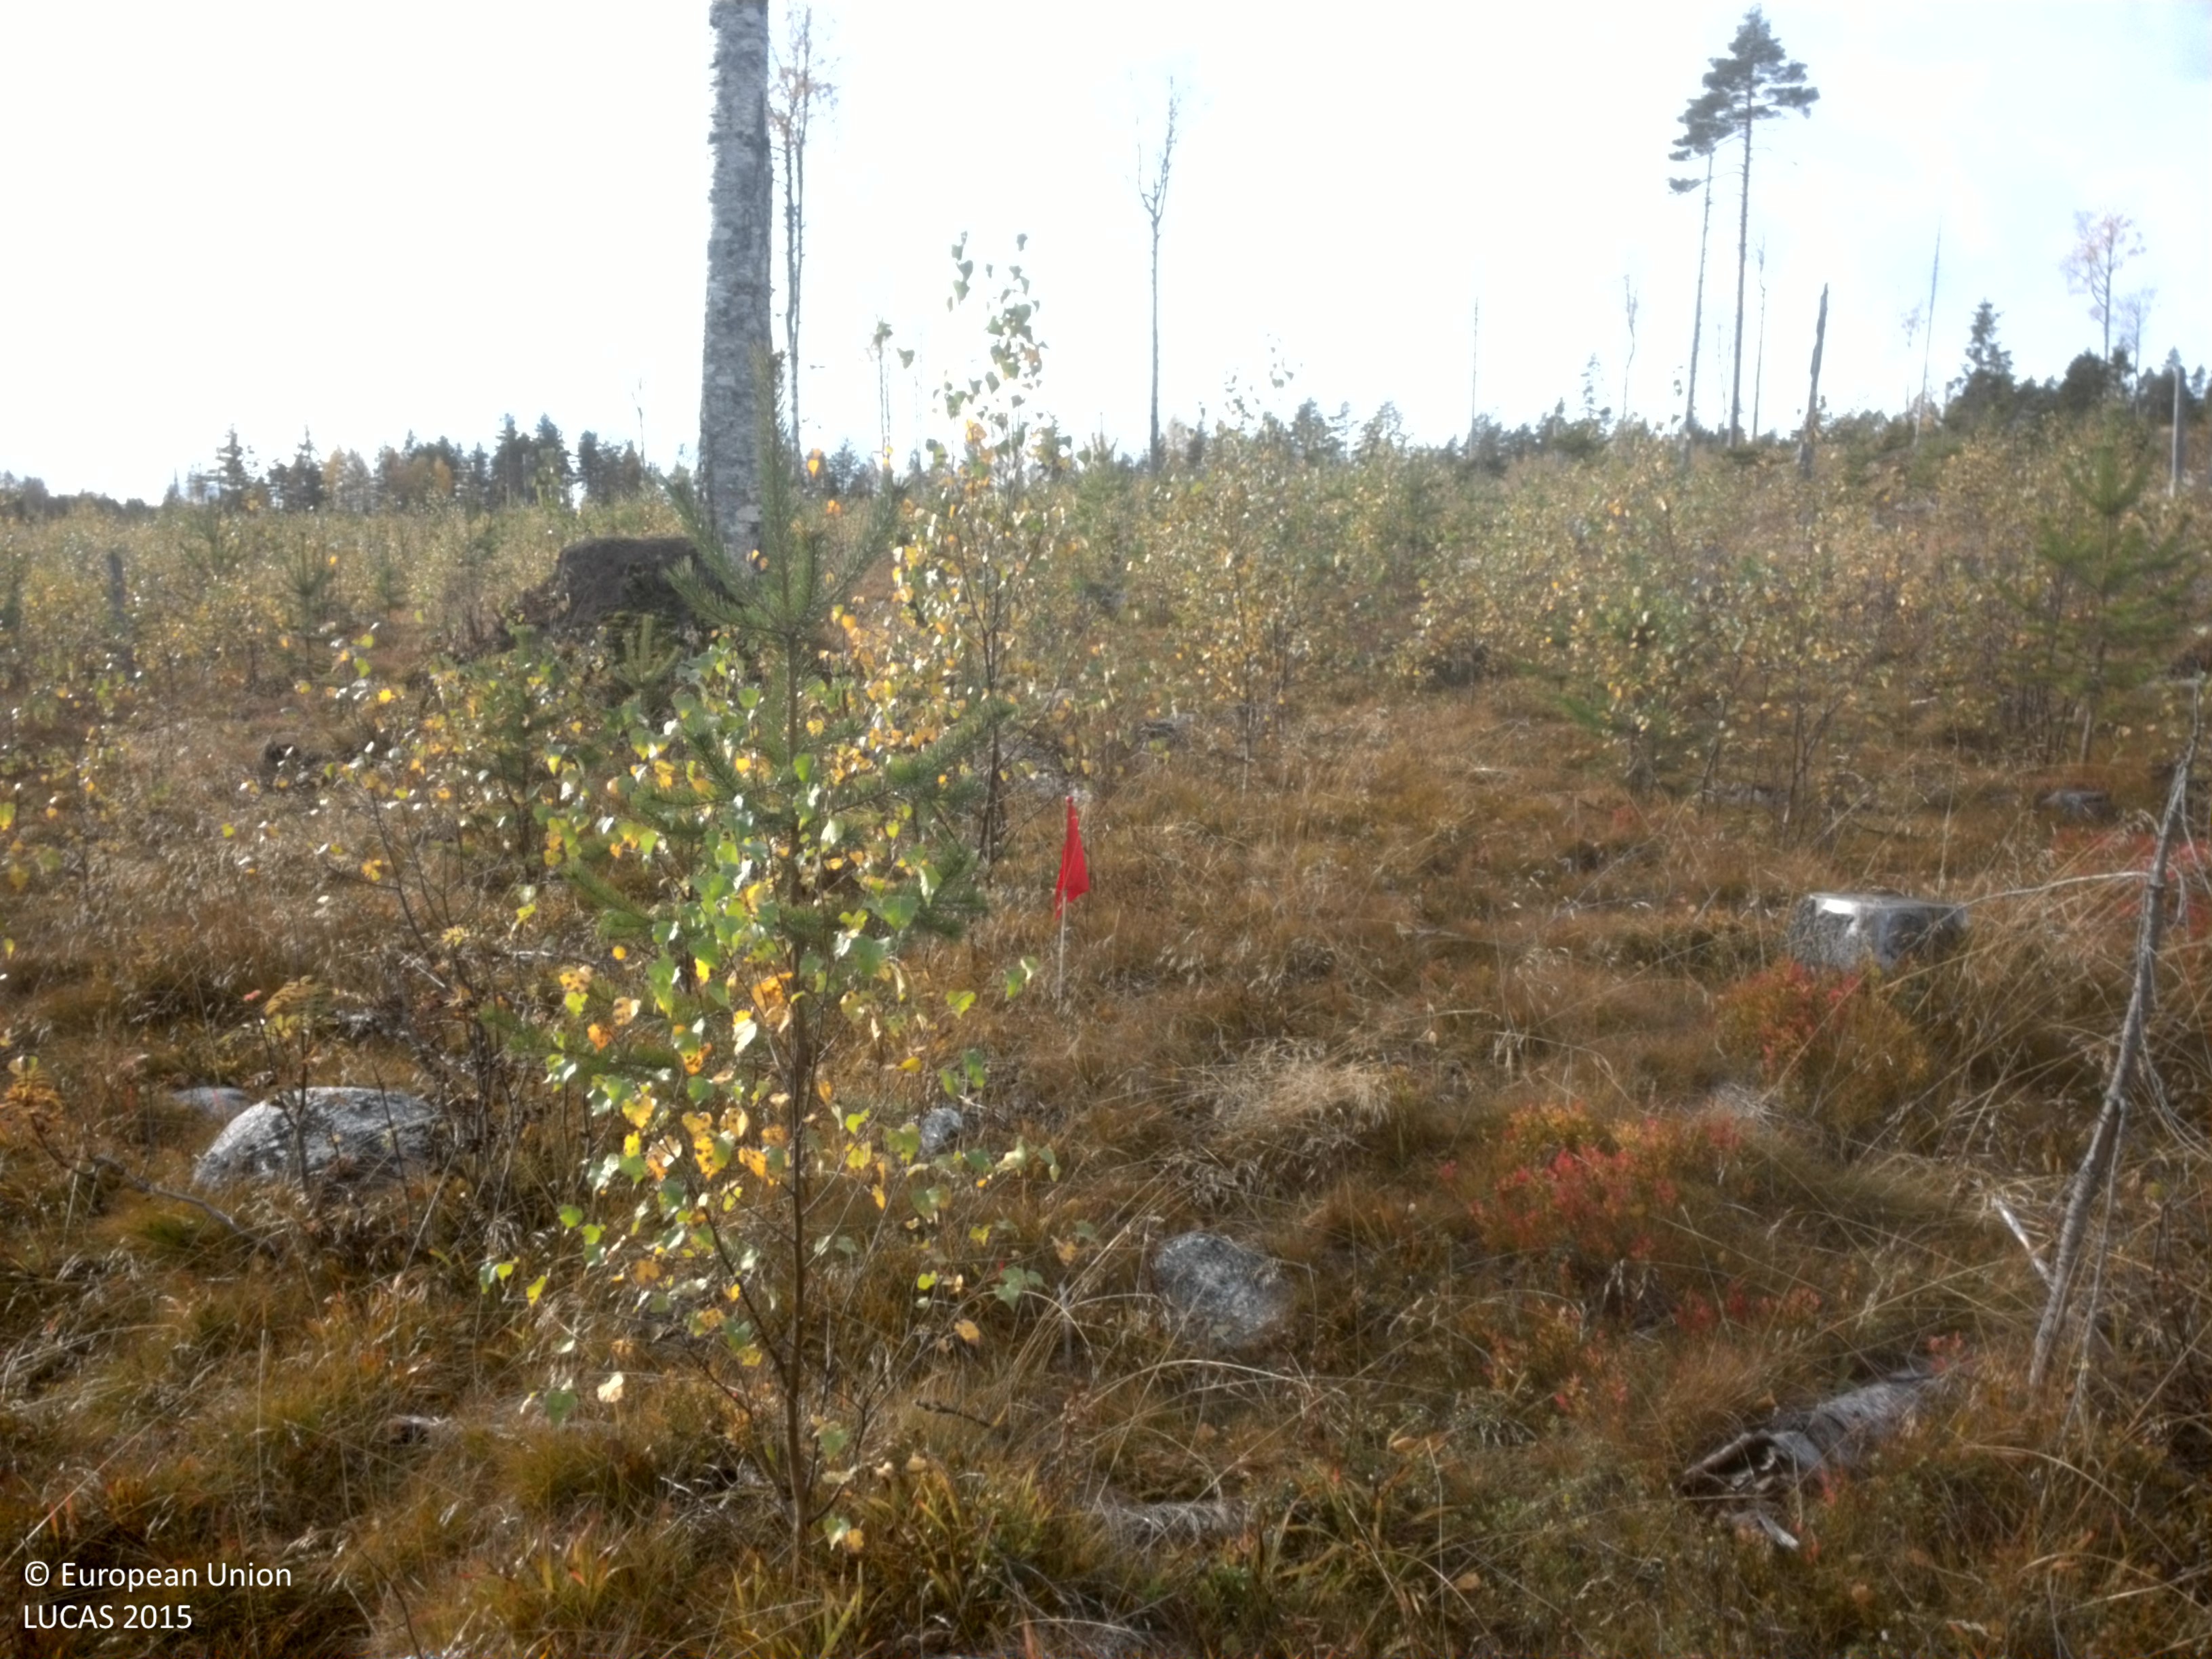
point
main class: Woodland
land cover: Broadleaved woodland
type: boreal forest
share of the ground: 50 - 75 %
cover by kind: broadleaved forest trees 45 %, herbaceous plants 40 %, shrubs 10 %, coniferous forest trees 5 %
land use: Forestry
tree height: < 5 m
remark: Clear cut
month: October
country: SE
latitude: 64.0560
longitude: 20.1198
